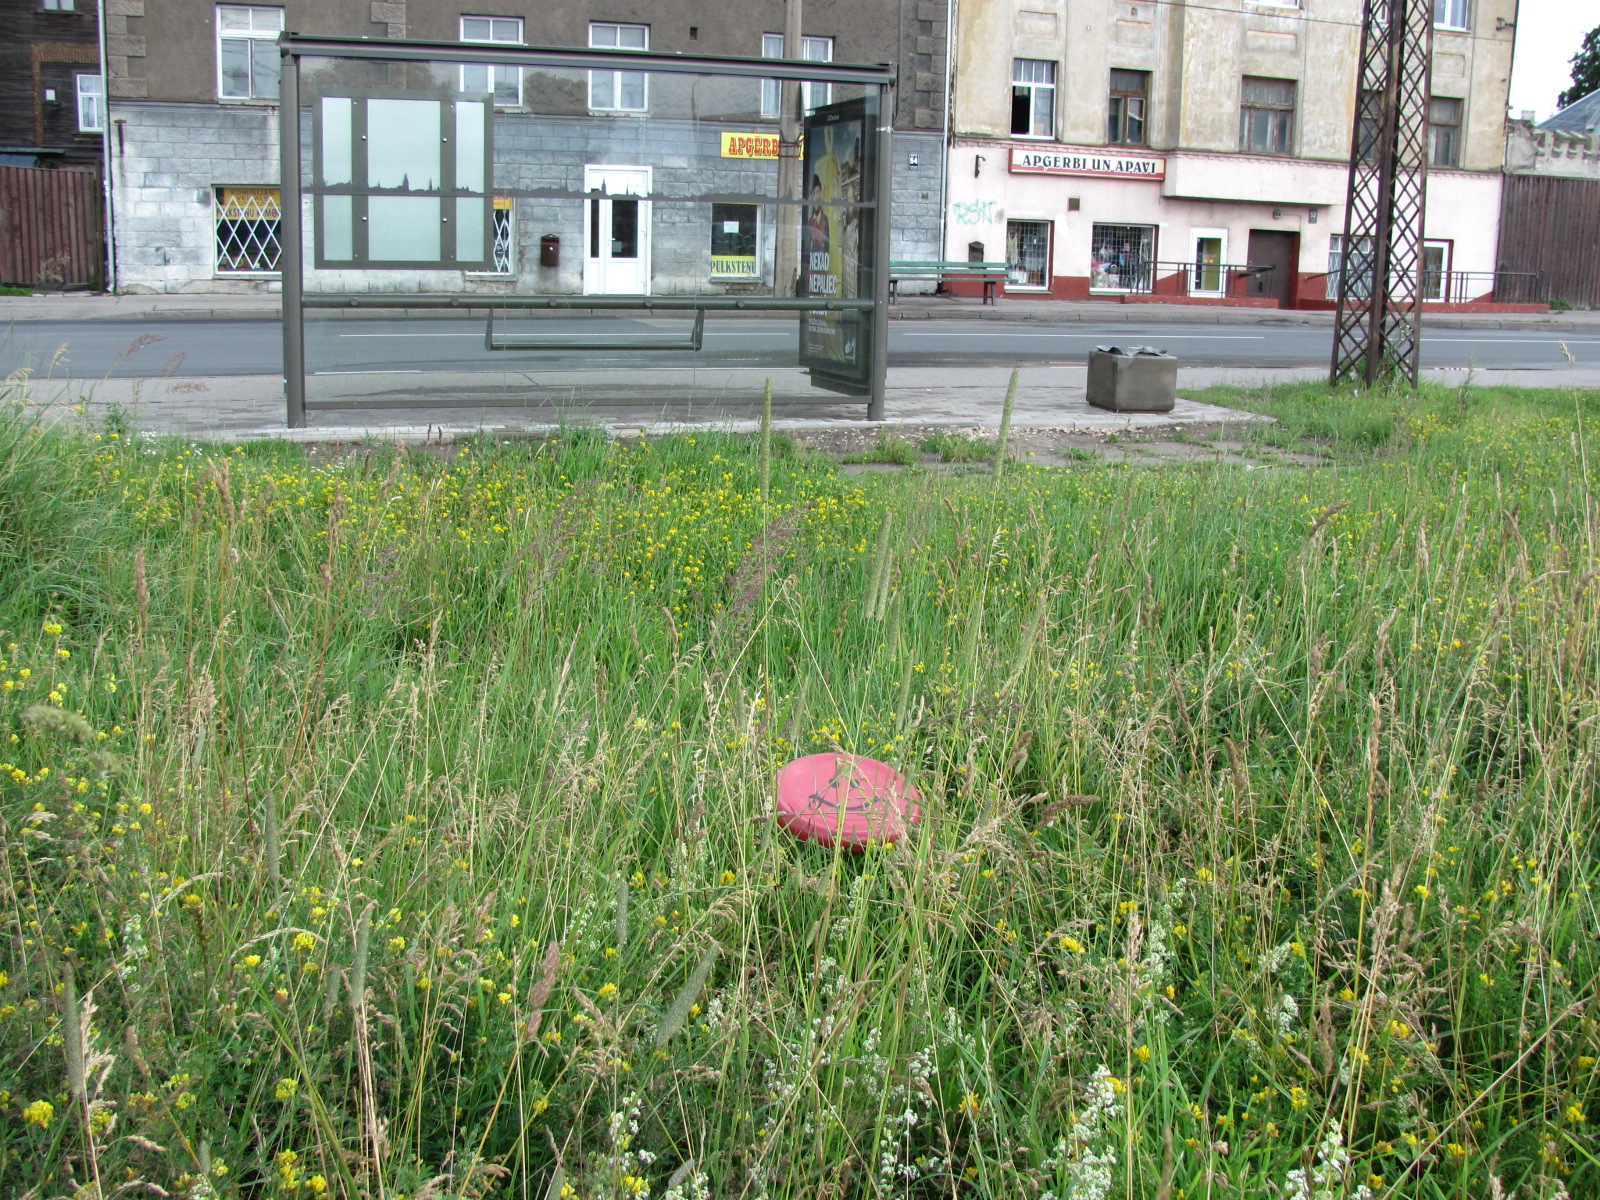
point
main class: Grassland
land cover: Grassland without tree/shrub cover
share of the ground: > 75 %
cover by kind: herbaceous plants 100 %
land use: Community services
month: July
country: LV
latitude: 56.9923
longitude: 24.1253
